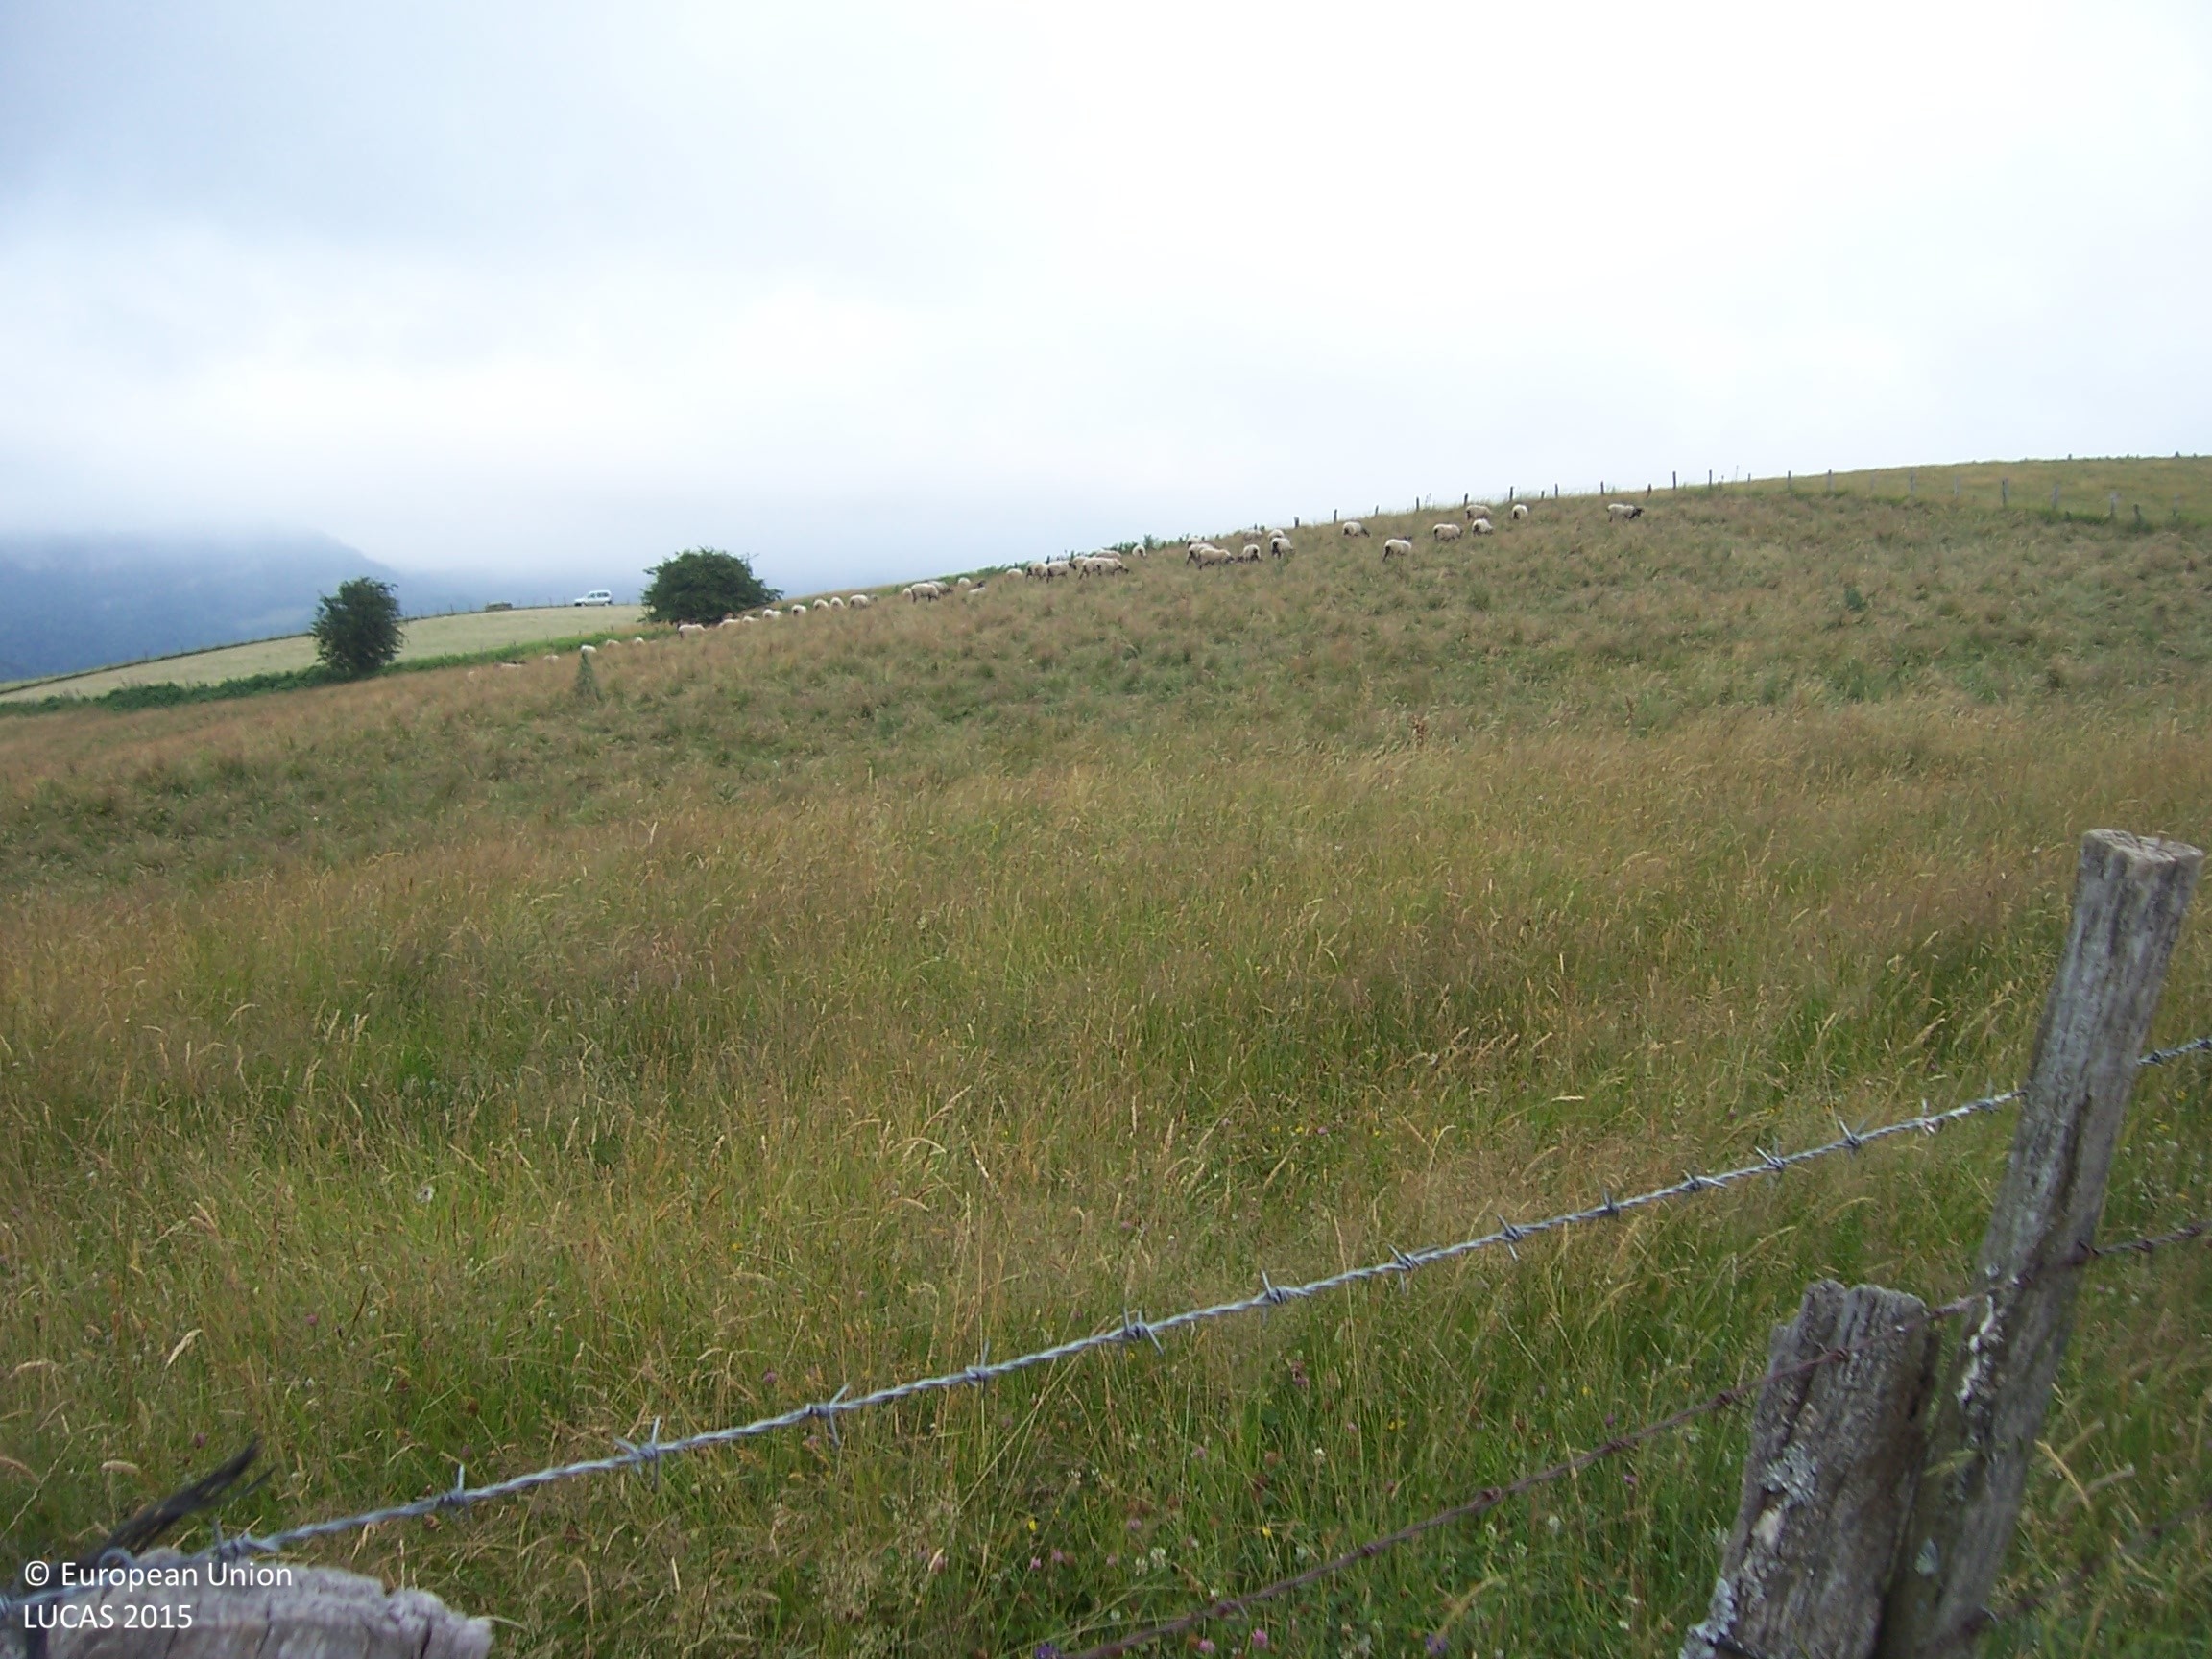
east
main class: Grassland
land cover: Grassland without tree/shrub cover
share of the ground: > 75 %
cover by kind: herbaceous plants 100 %
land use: Agriculture (excluding fallow land and kitchen gardens)
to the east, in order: Grass margins; Fences; Grassland without tree/shrub cover; Fences; Grassland without tree/shrub cover; Fences; Grassland without tree/shrub cover
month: July
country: ES
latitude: 42.9663
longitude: -1.3039
